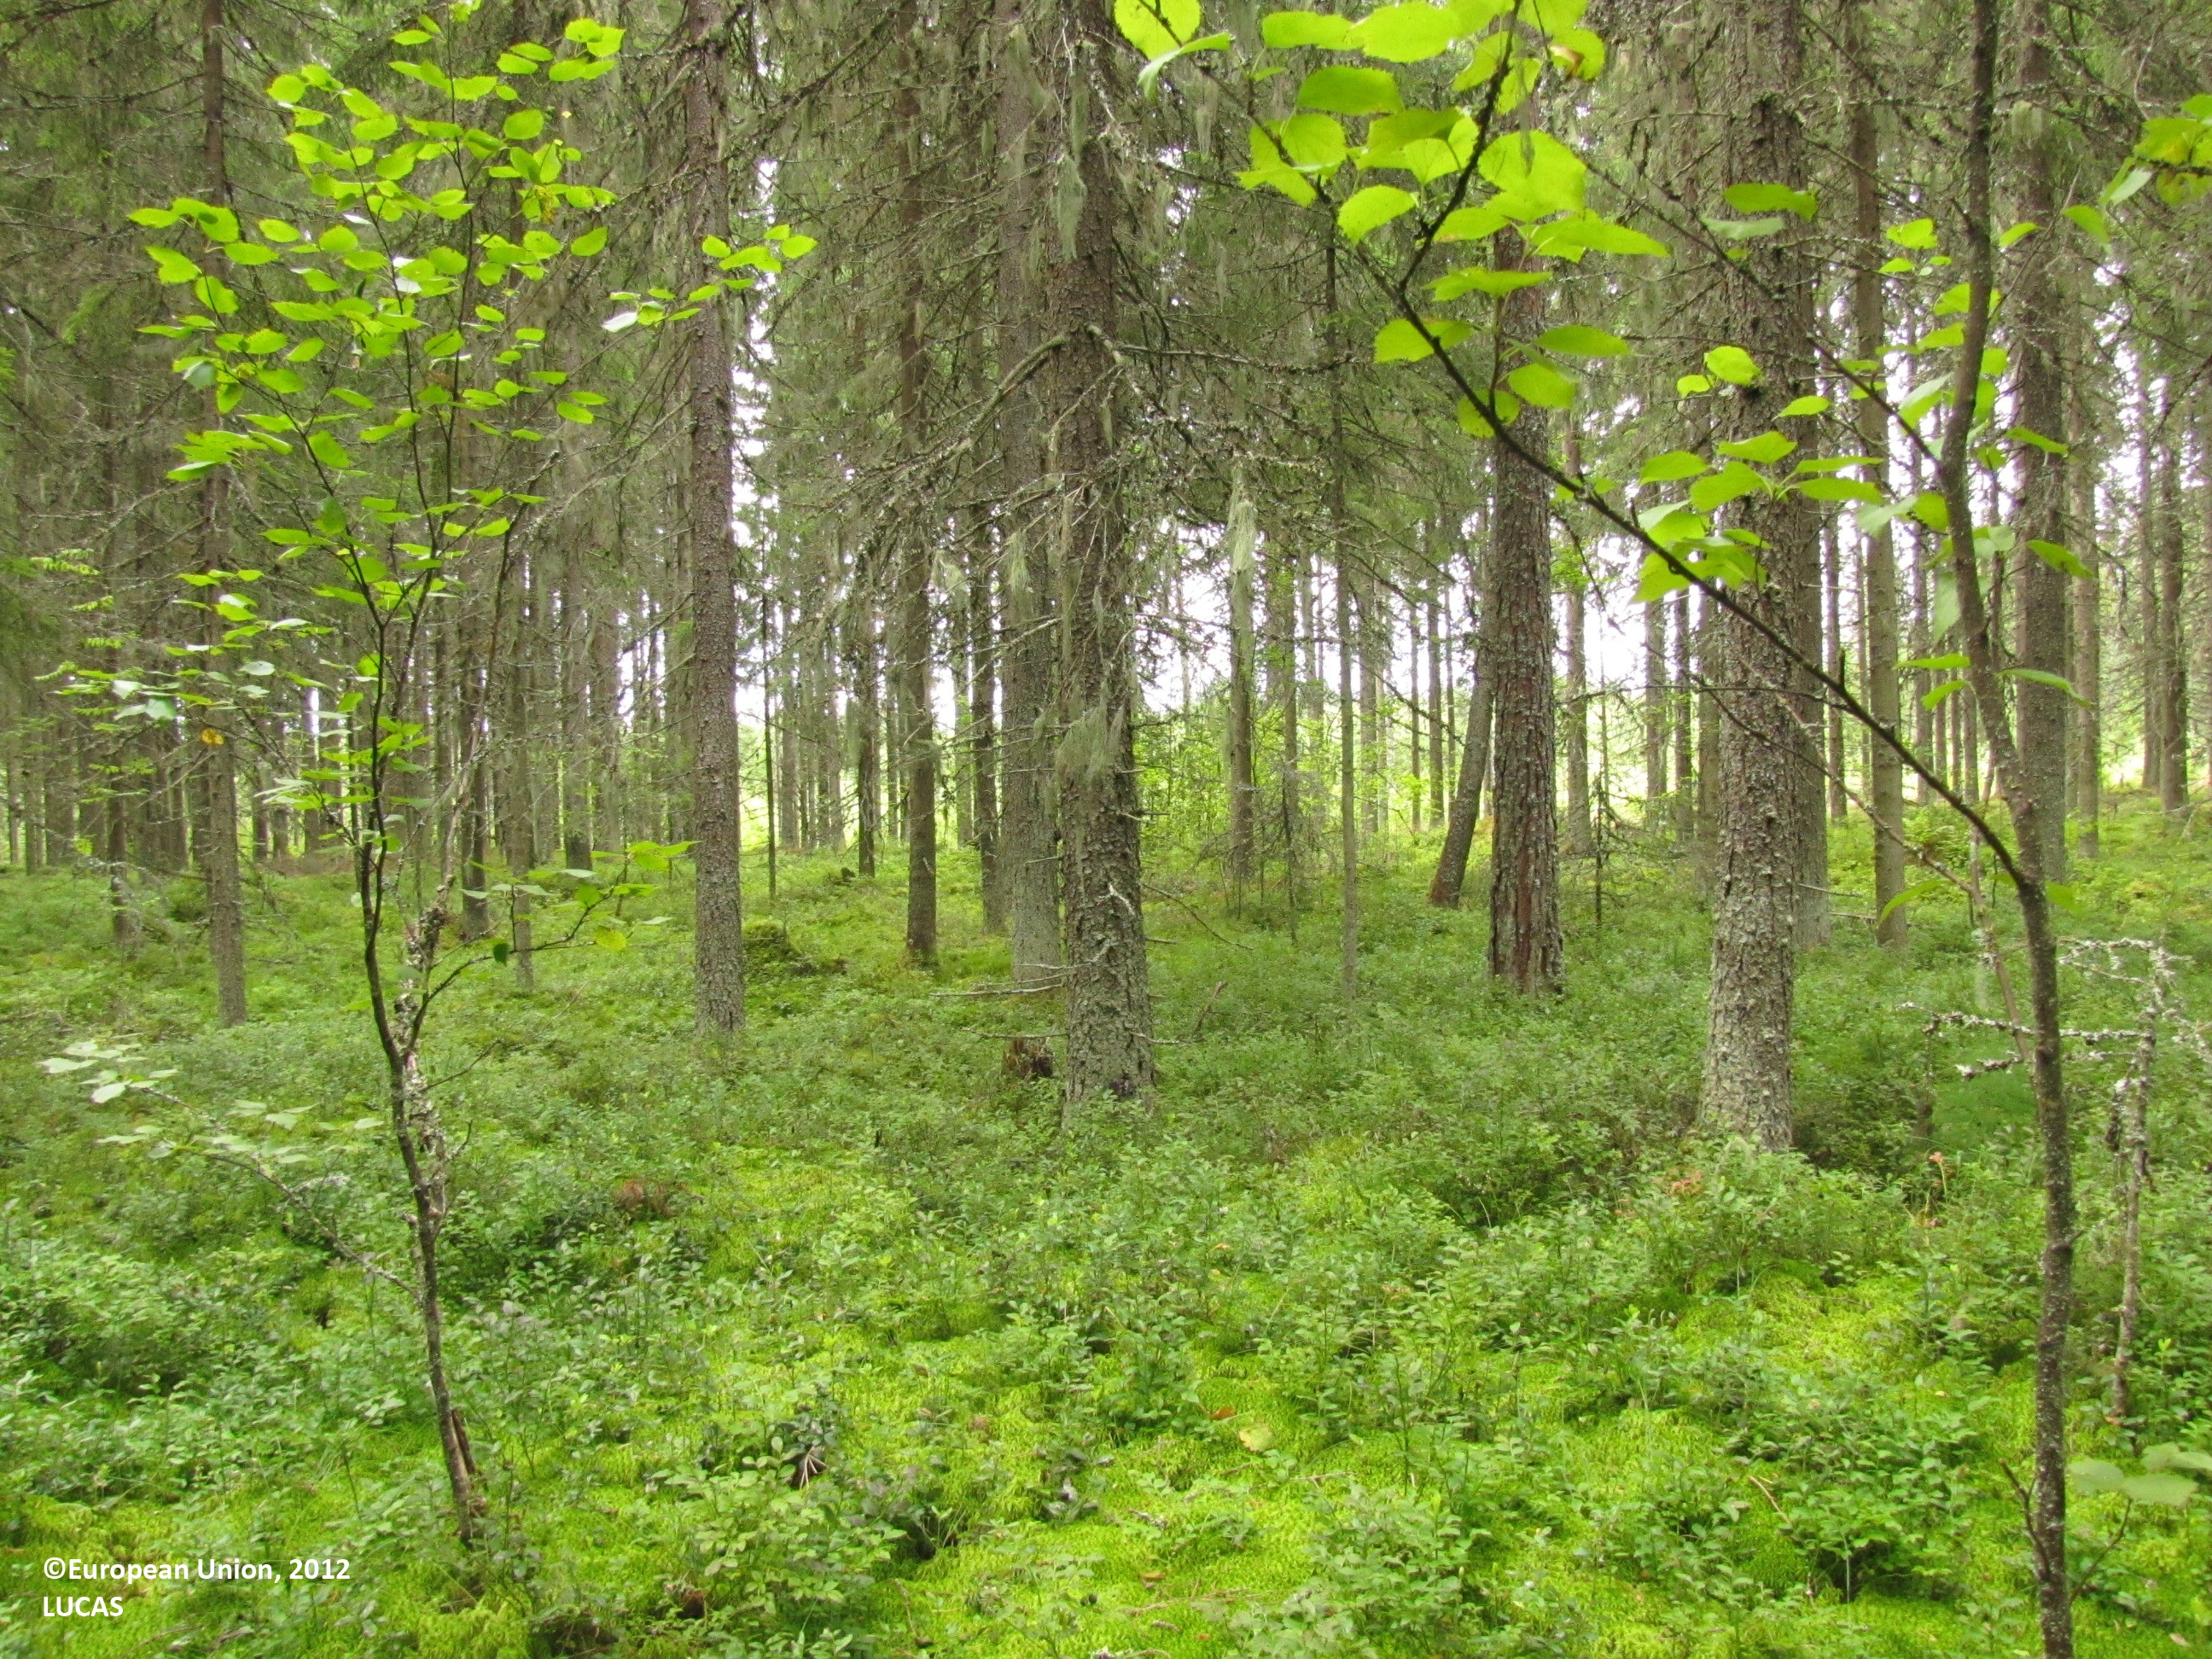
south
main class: Woodland
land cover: Spruce dominated coniferous woodland
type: boreal forest
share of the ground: > 75 %
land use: Forestry
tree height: > 5 m
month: August
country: FI
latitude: 61.8361
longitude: 22.8862
